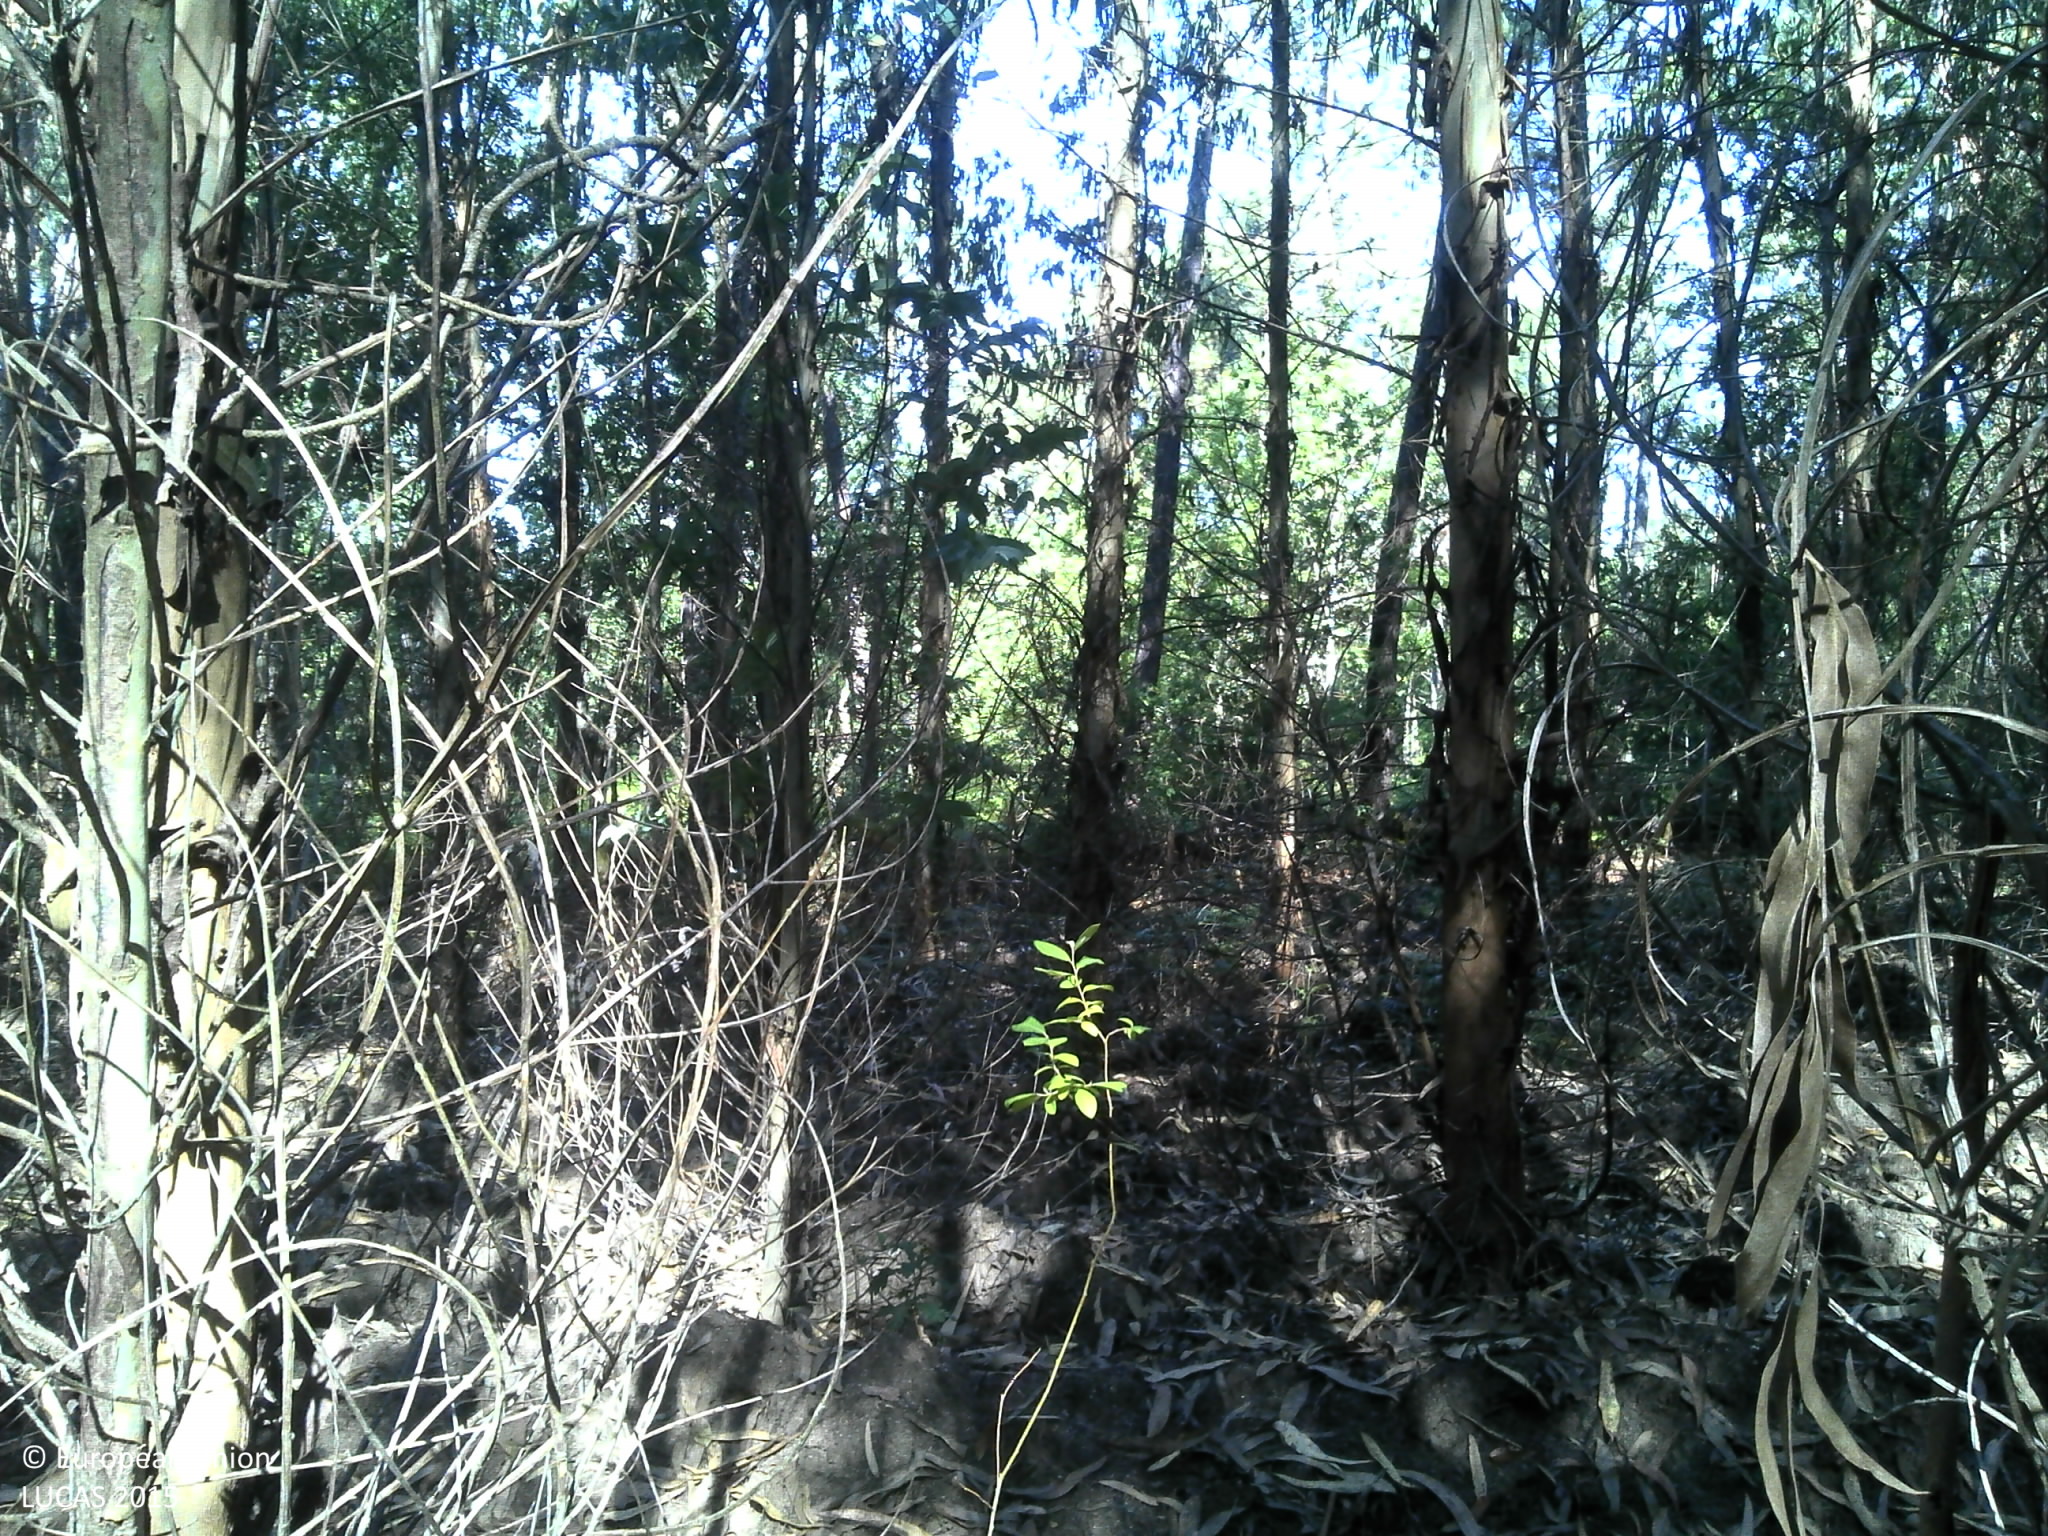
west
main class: Woodland
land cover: Broadleaved woodland
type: exotic forest
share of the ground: > 75 %
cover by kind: broadleaved forest trees 75 %, unconsolidated bare surface 20 %, shrubs 5 %
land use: Forestry
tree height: > 5 m
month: June
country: PT
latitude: 40.5871
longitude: -8.0746
